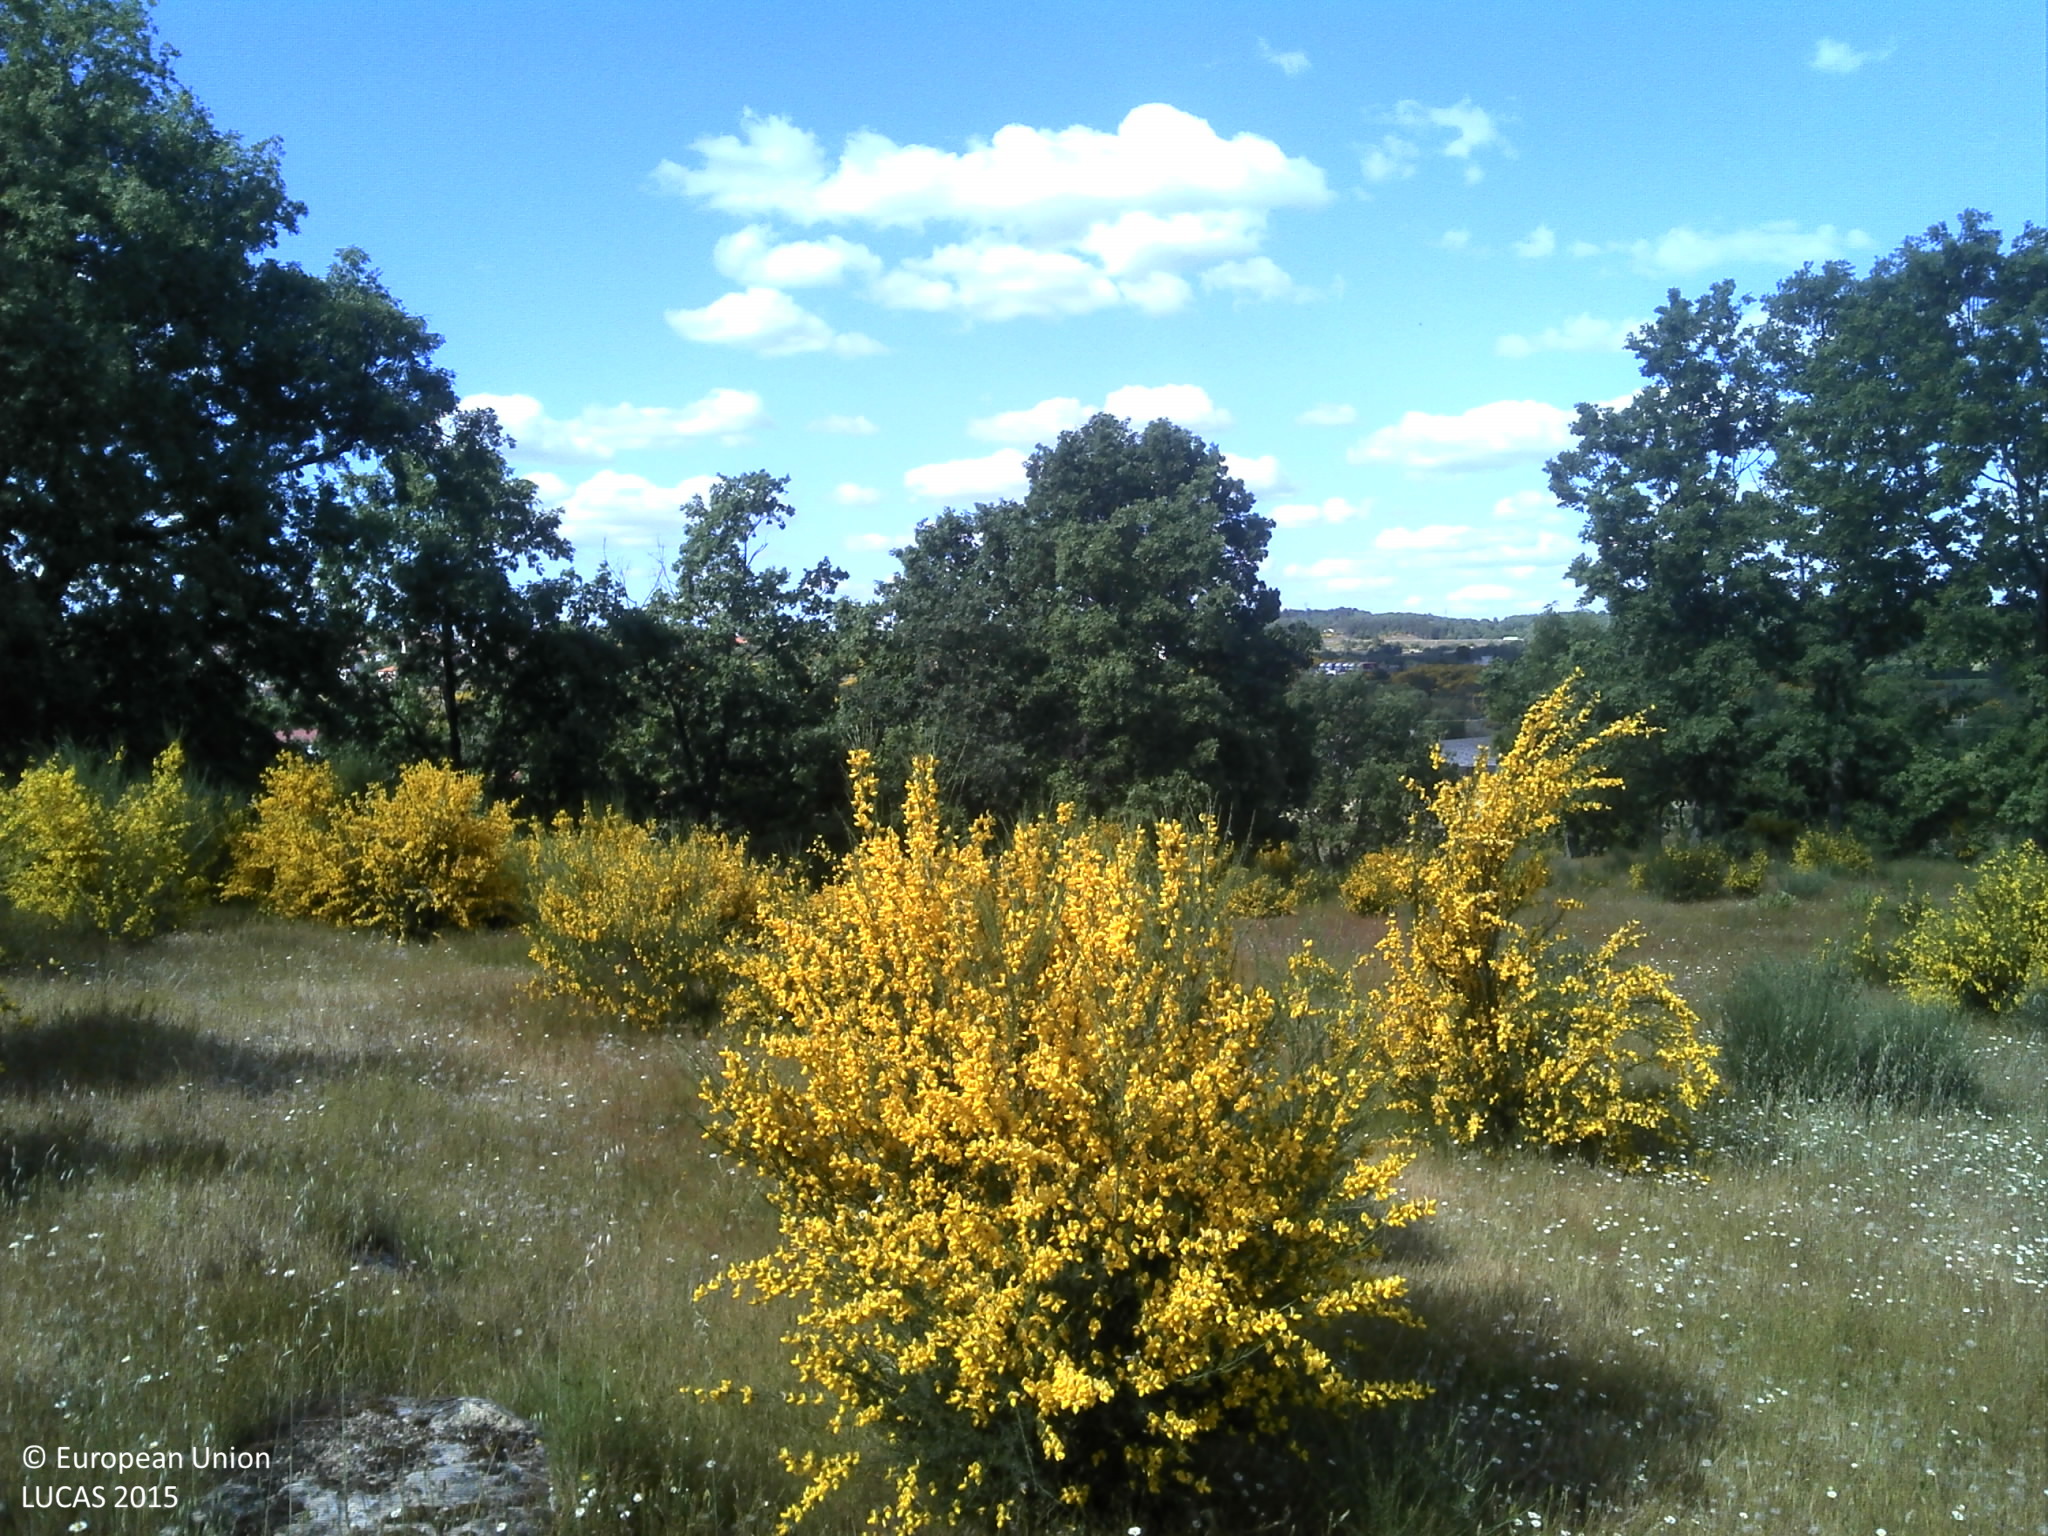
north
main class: Grassland
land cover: Grassland with sparse tree/shrub cover
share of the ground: 50 - 75 %
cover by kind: herbaceous plants 70 %, unconsolidated bare surface 20 %, broadleaved forest trees 5 %, shrubs 5 %
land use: Agriculture (excluding fallow land and kitchen gardens)
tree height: > 5 m
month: May
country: PT
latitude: 40.5366
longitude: -7.2358
